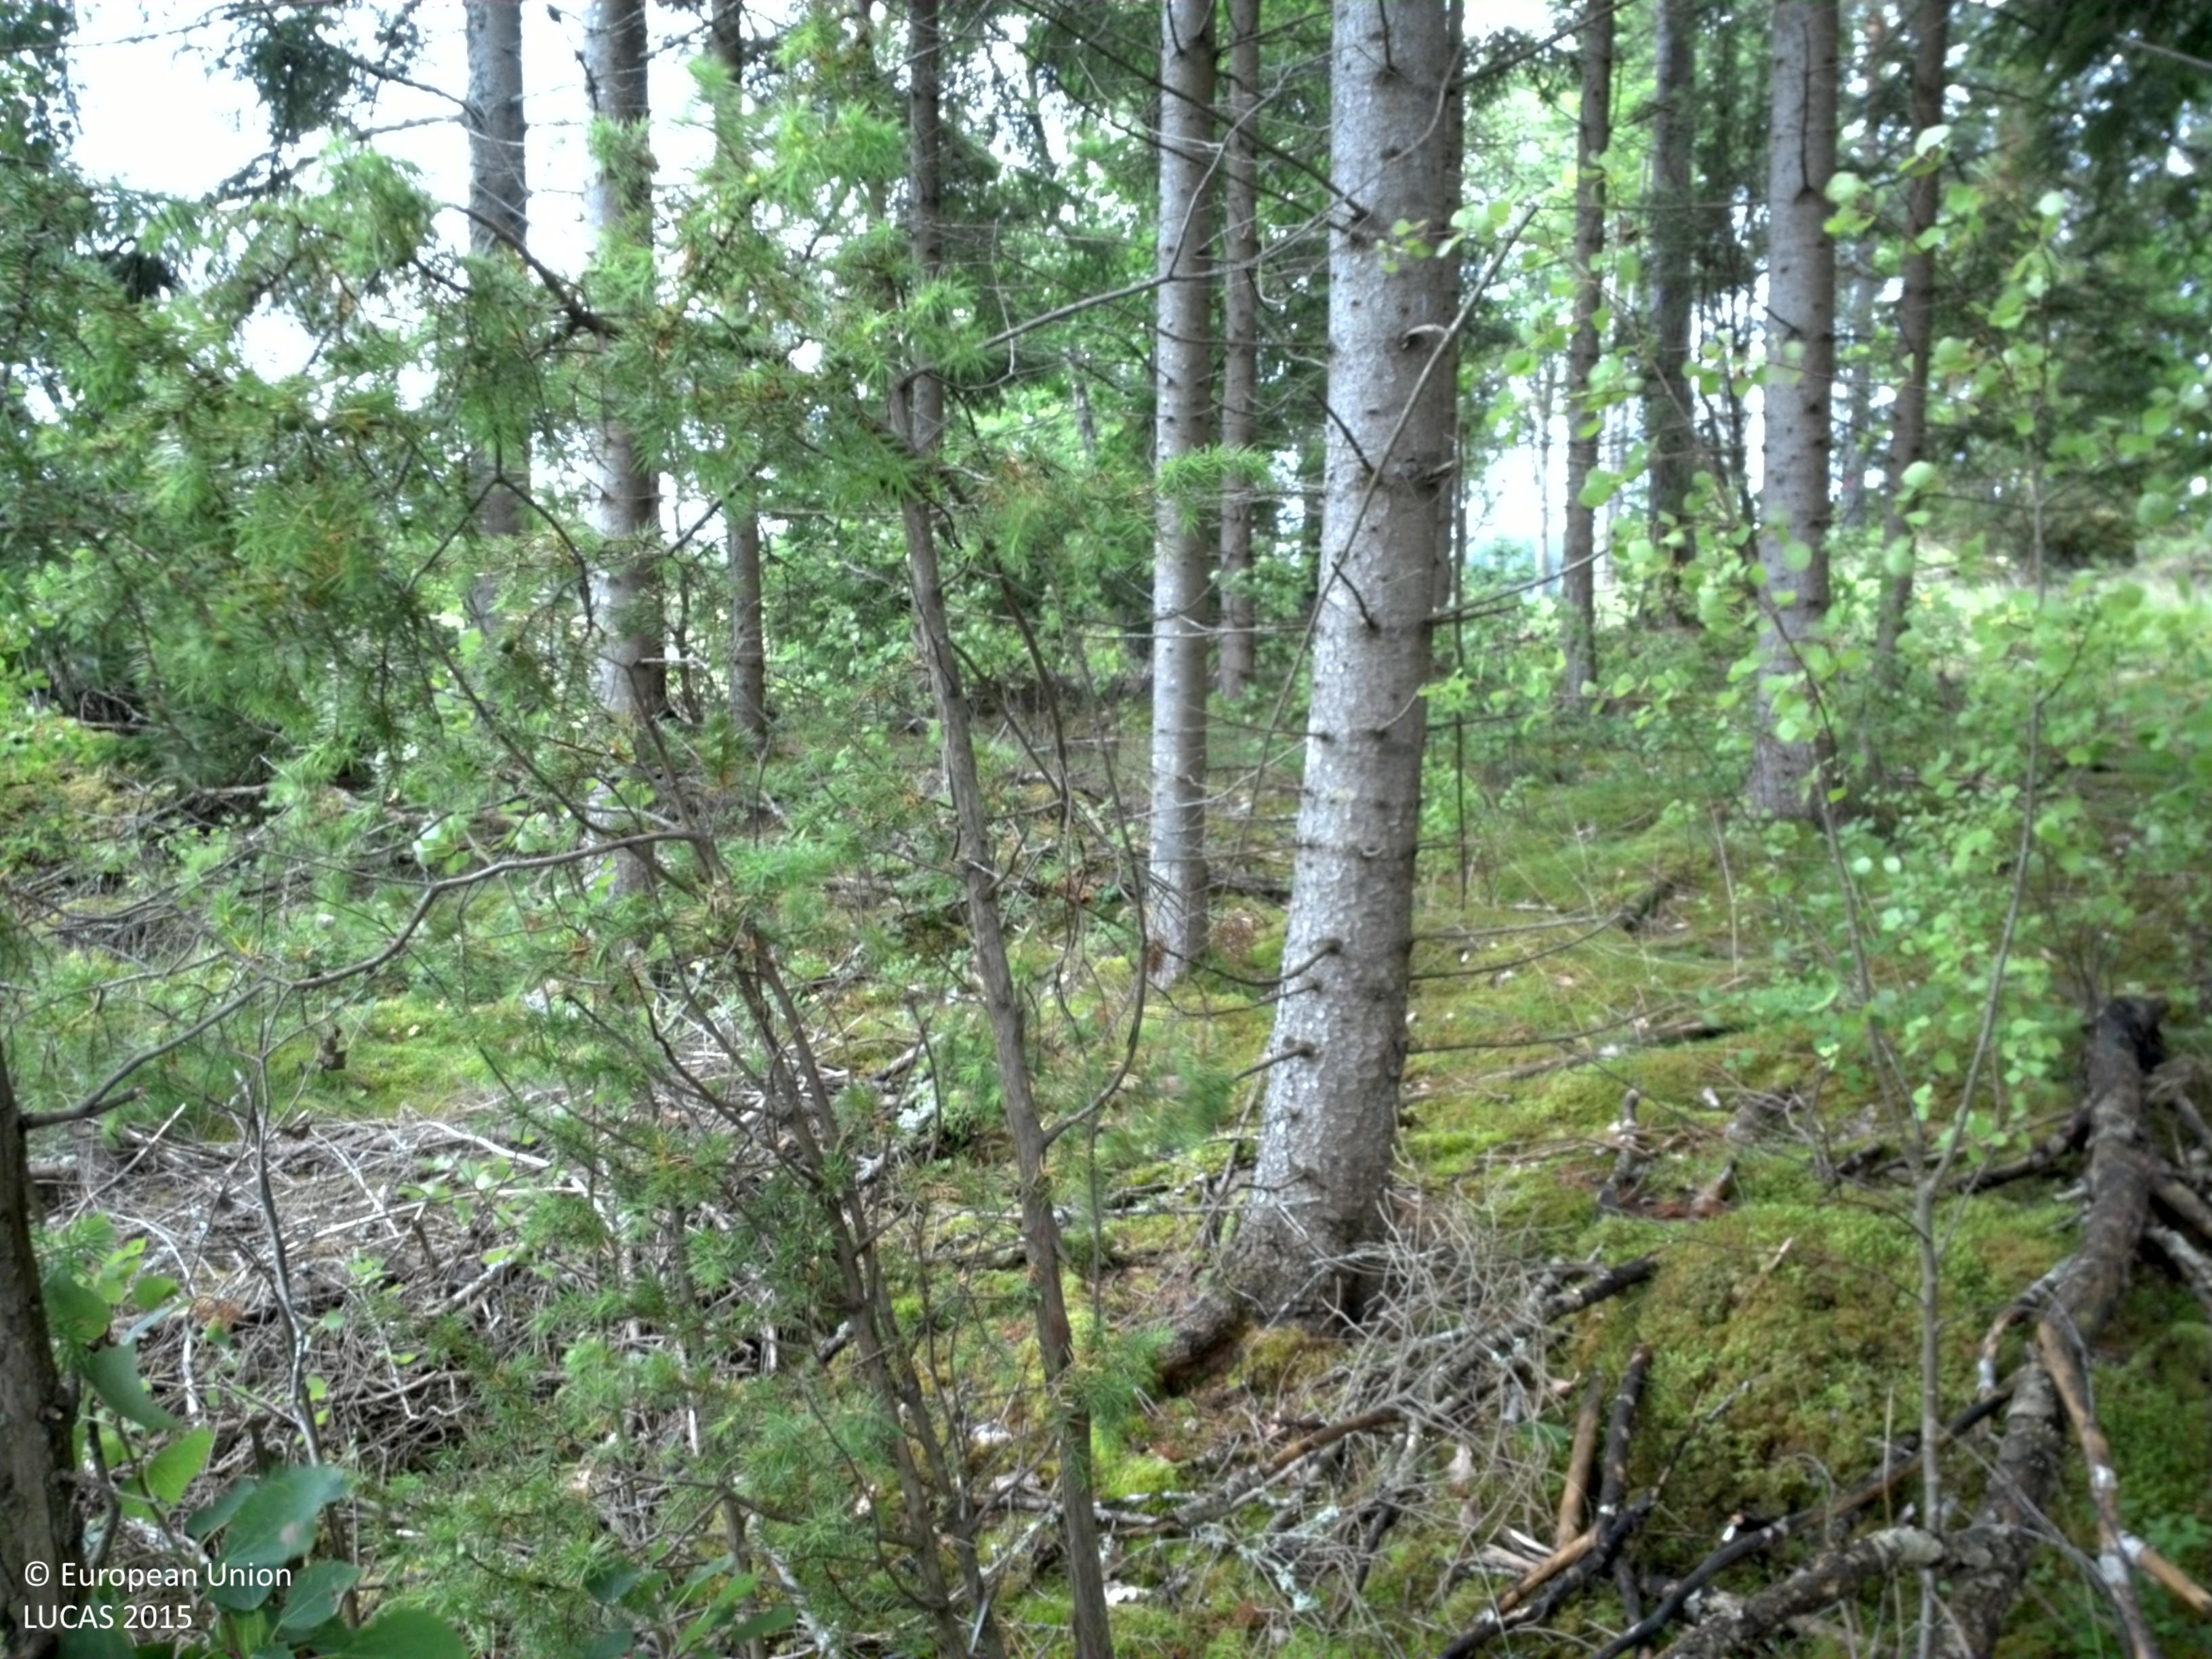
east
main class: Woodland
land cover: Spruce dominated coniferous woodland
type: boreal forest
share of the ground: 25 - 50 %
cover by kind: coniferous forest trees 45 %, lichens and mosses 30 %, herbaceous plants 20 %, broadleaved forest trees 5 %
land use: Forestry
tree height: > 5 m
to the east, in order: Spruce dominated coniferous woodland; Ditches and canals; Common wheat; Tracks; Ditches and canals; Electric lines; Common wheat
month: July
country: SE
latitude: 58.7077
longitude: 15.3617
